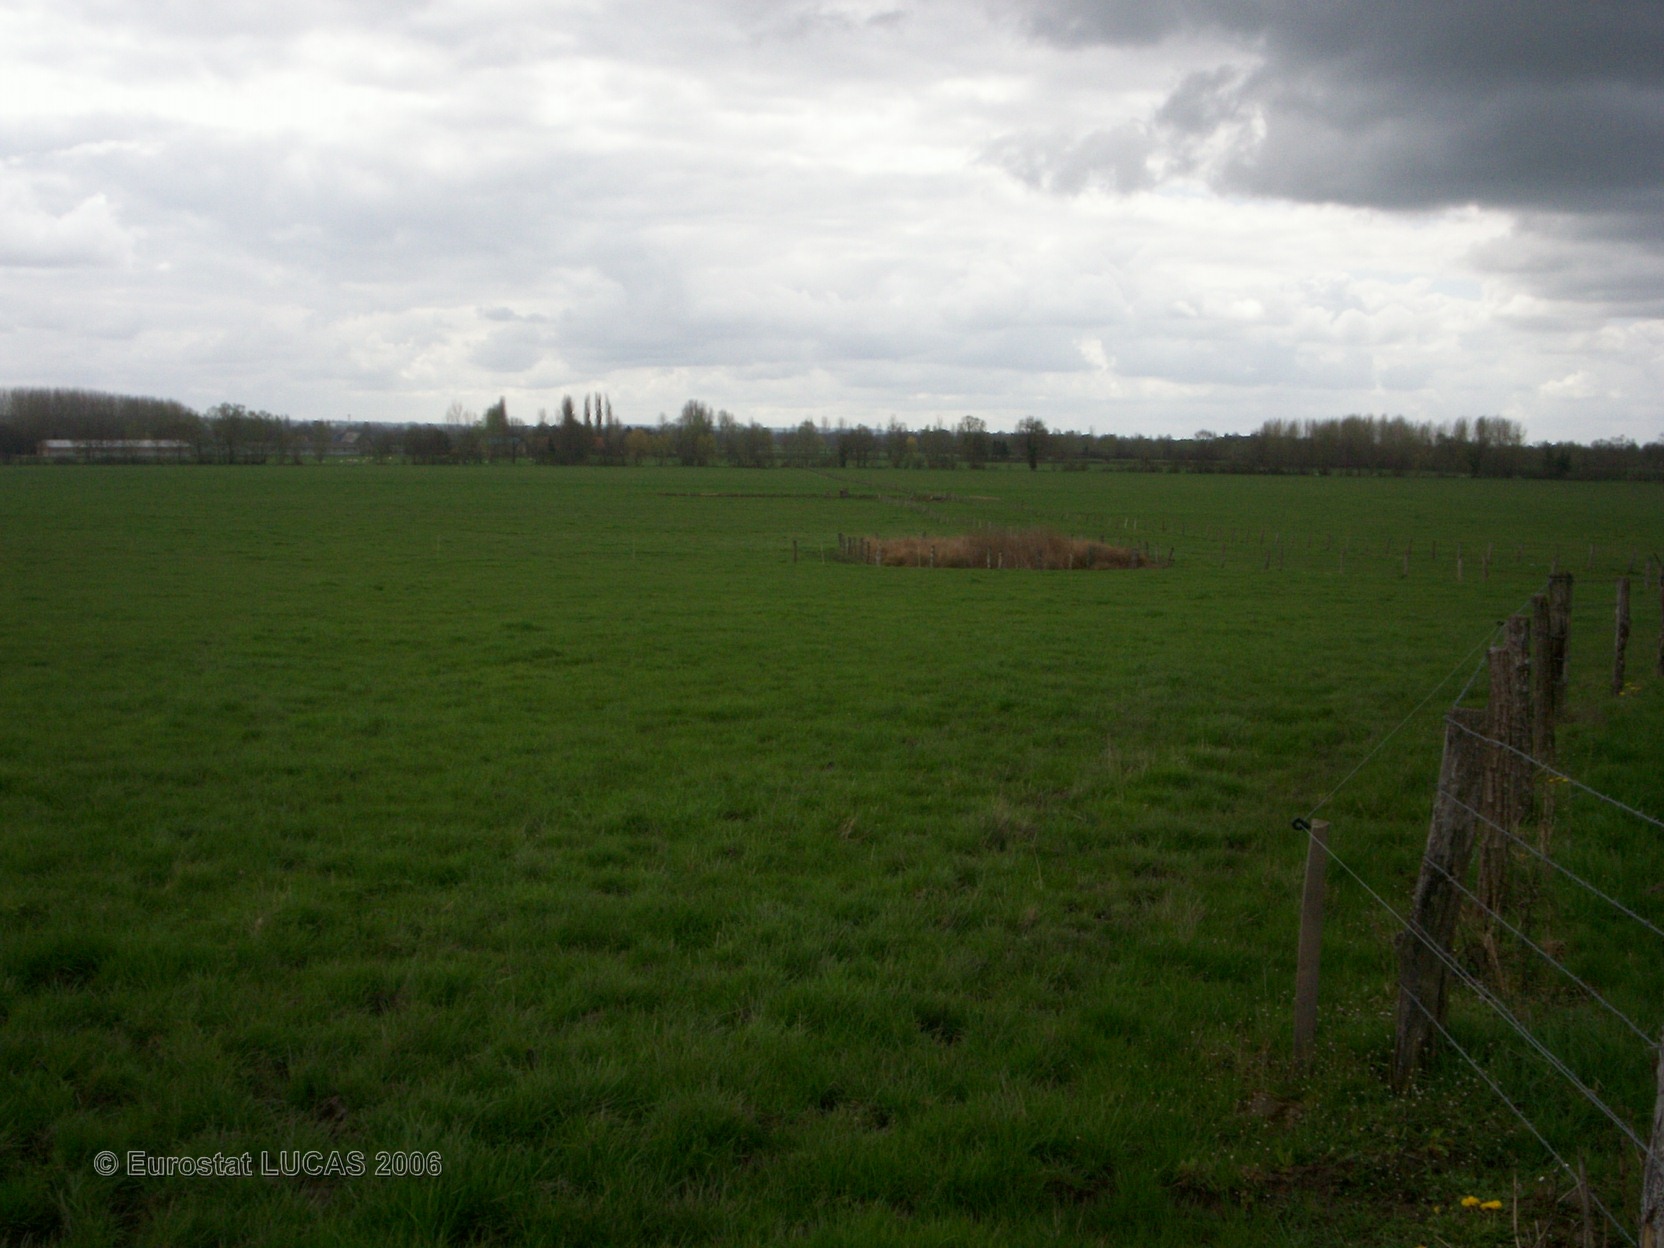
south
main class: Grassland
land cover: Grassland without tree/shrub cover
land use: Agriculture (excluding fallow land and kitchen gardens)
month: April
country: FR
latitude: 46.8698
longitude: 3.1088
